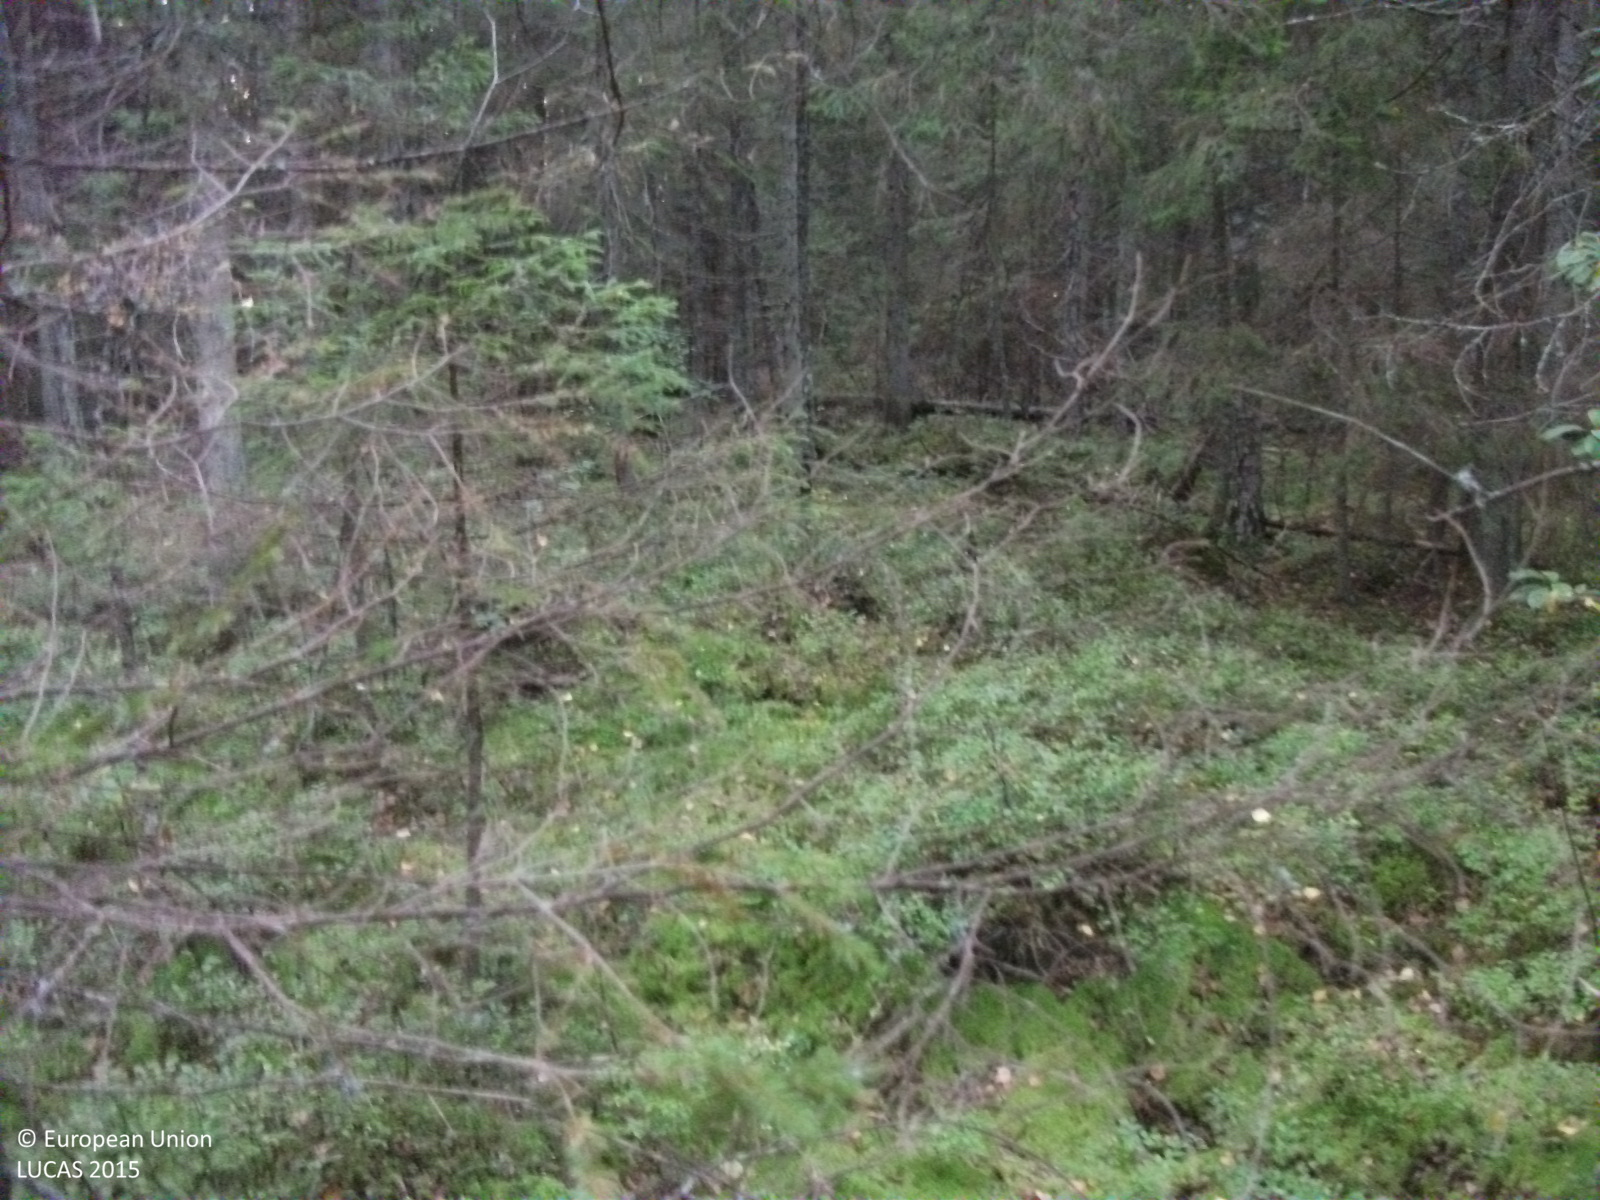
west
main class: Woodland
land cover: Spruce dominated coniferous woodland
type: hemiboreal forest and nemoral coniferous forest and mixed broadleaved-coniferous forest
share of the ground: > 75 %
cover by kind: coniferous forest trees 90 %, shrubs 5 %, lichens and mosses 5 %
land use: Forestry
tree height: > 5 m
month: September
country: LV
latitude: 57.9333
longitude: 24.5629
